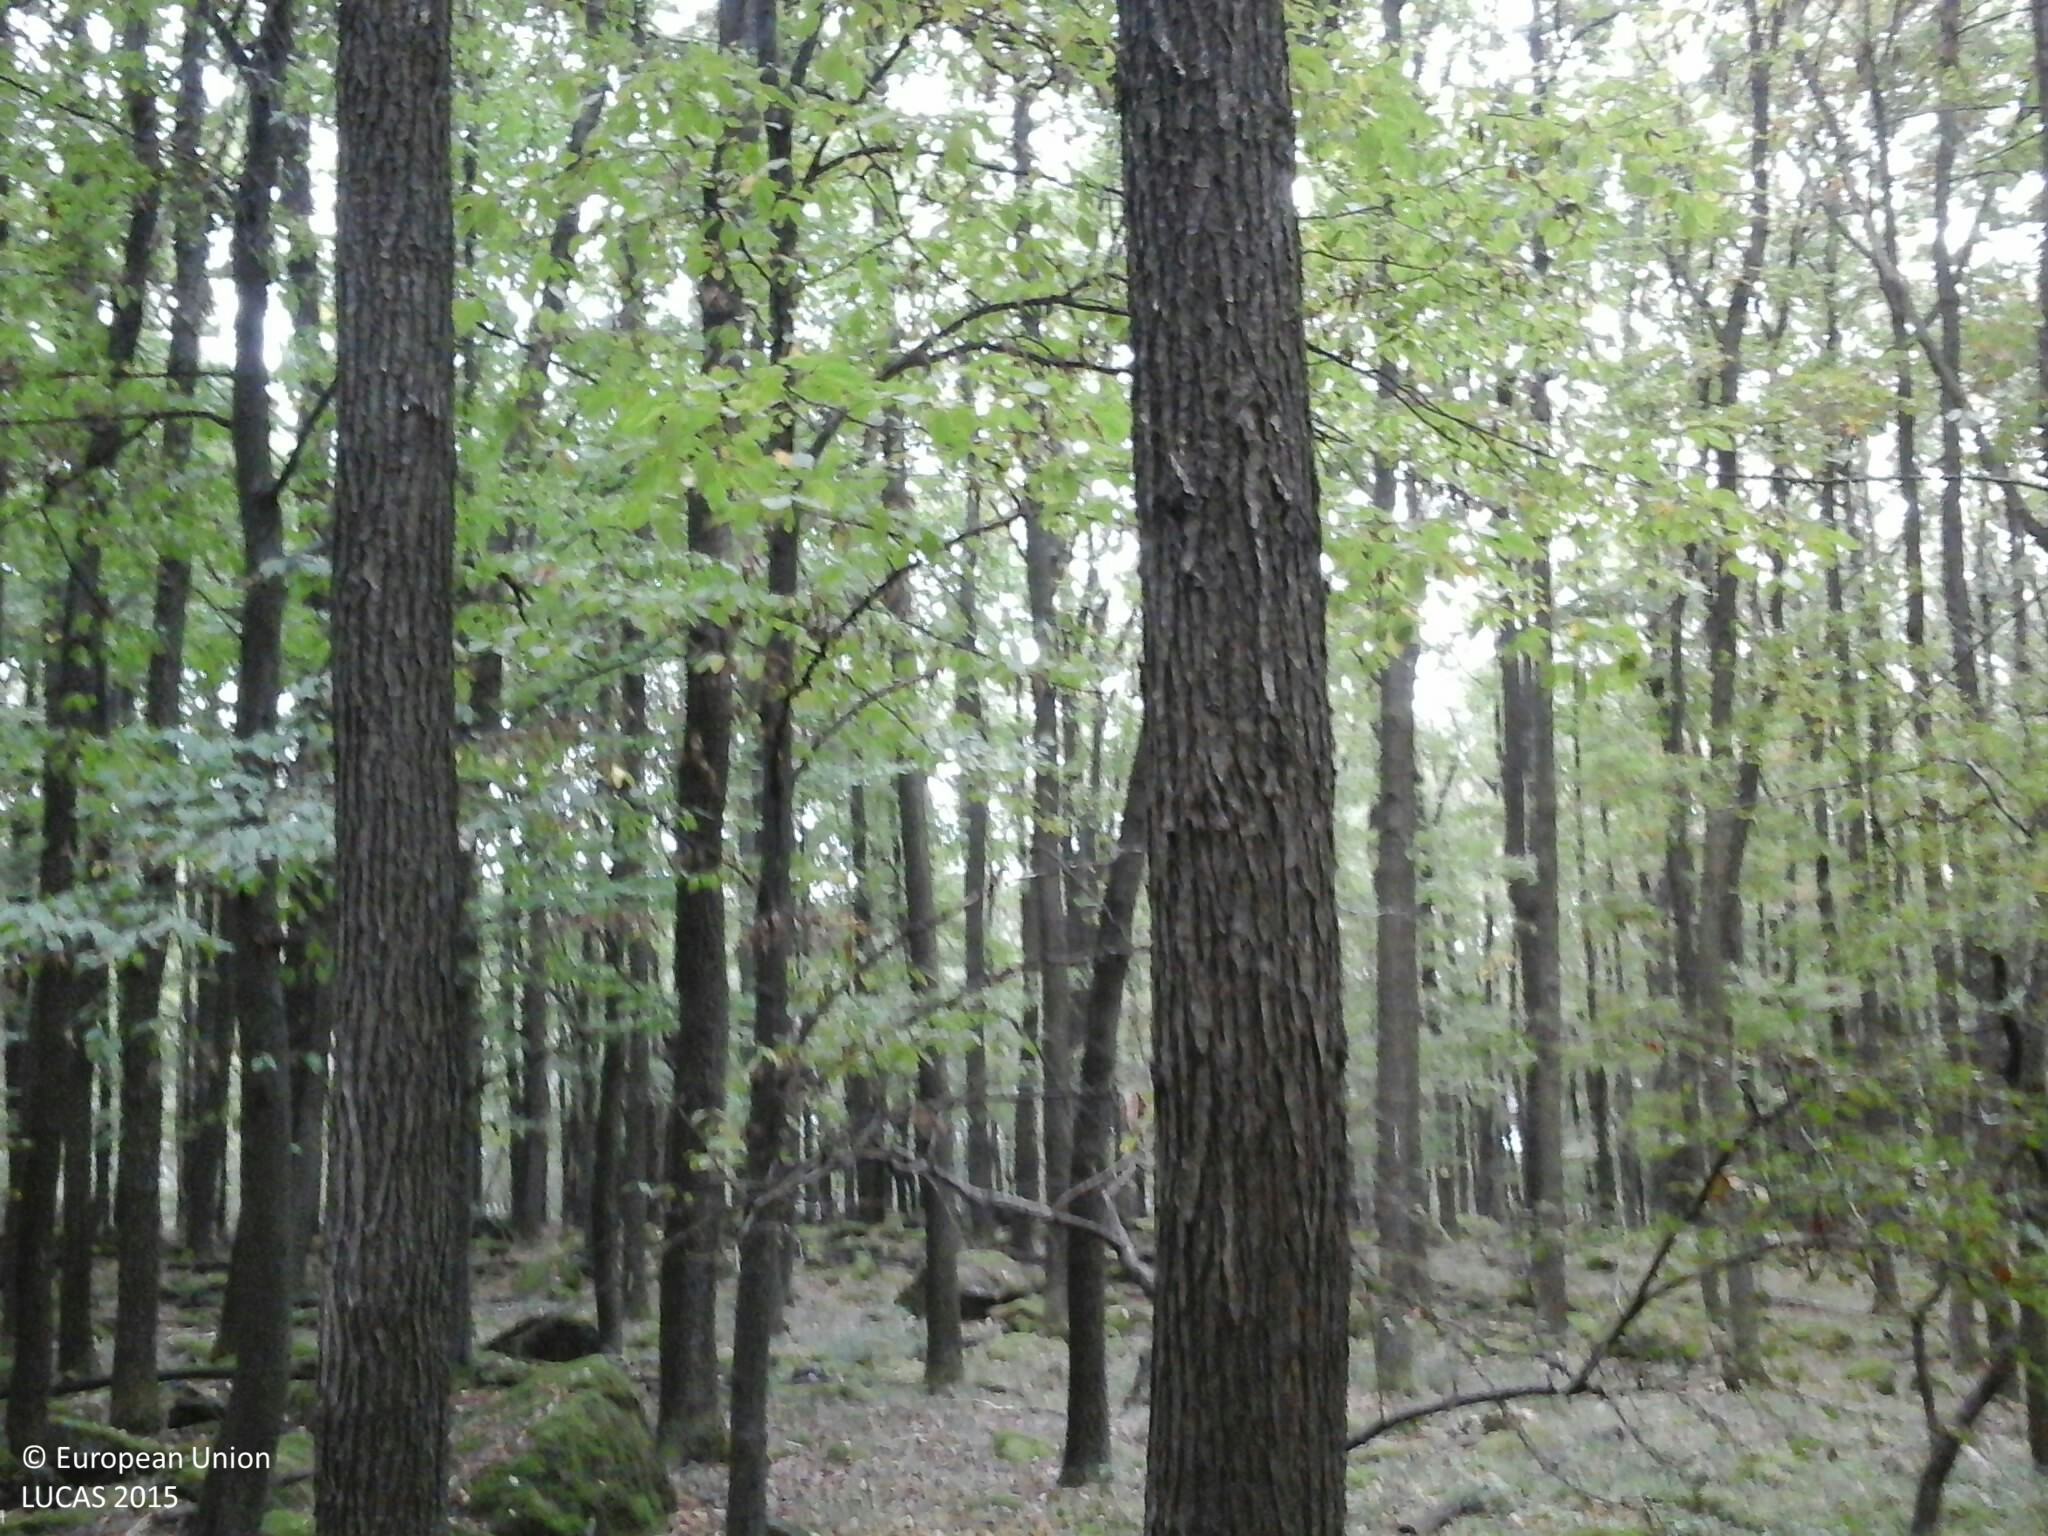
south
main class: Woodland
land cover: Broadleaved woodland
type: mesophytic deciduous forest
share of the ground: > 75 %
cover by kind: broadleaved forest trees 95 %, herbaceous plants 5 %
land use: Forestry
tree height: > 5 m
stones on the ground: 10 - 25 %
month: September
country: HU
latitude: 47.8597
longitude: 19.9853
